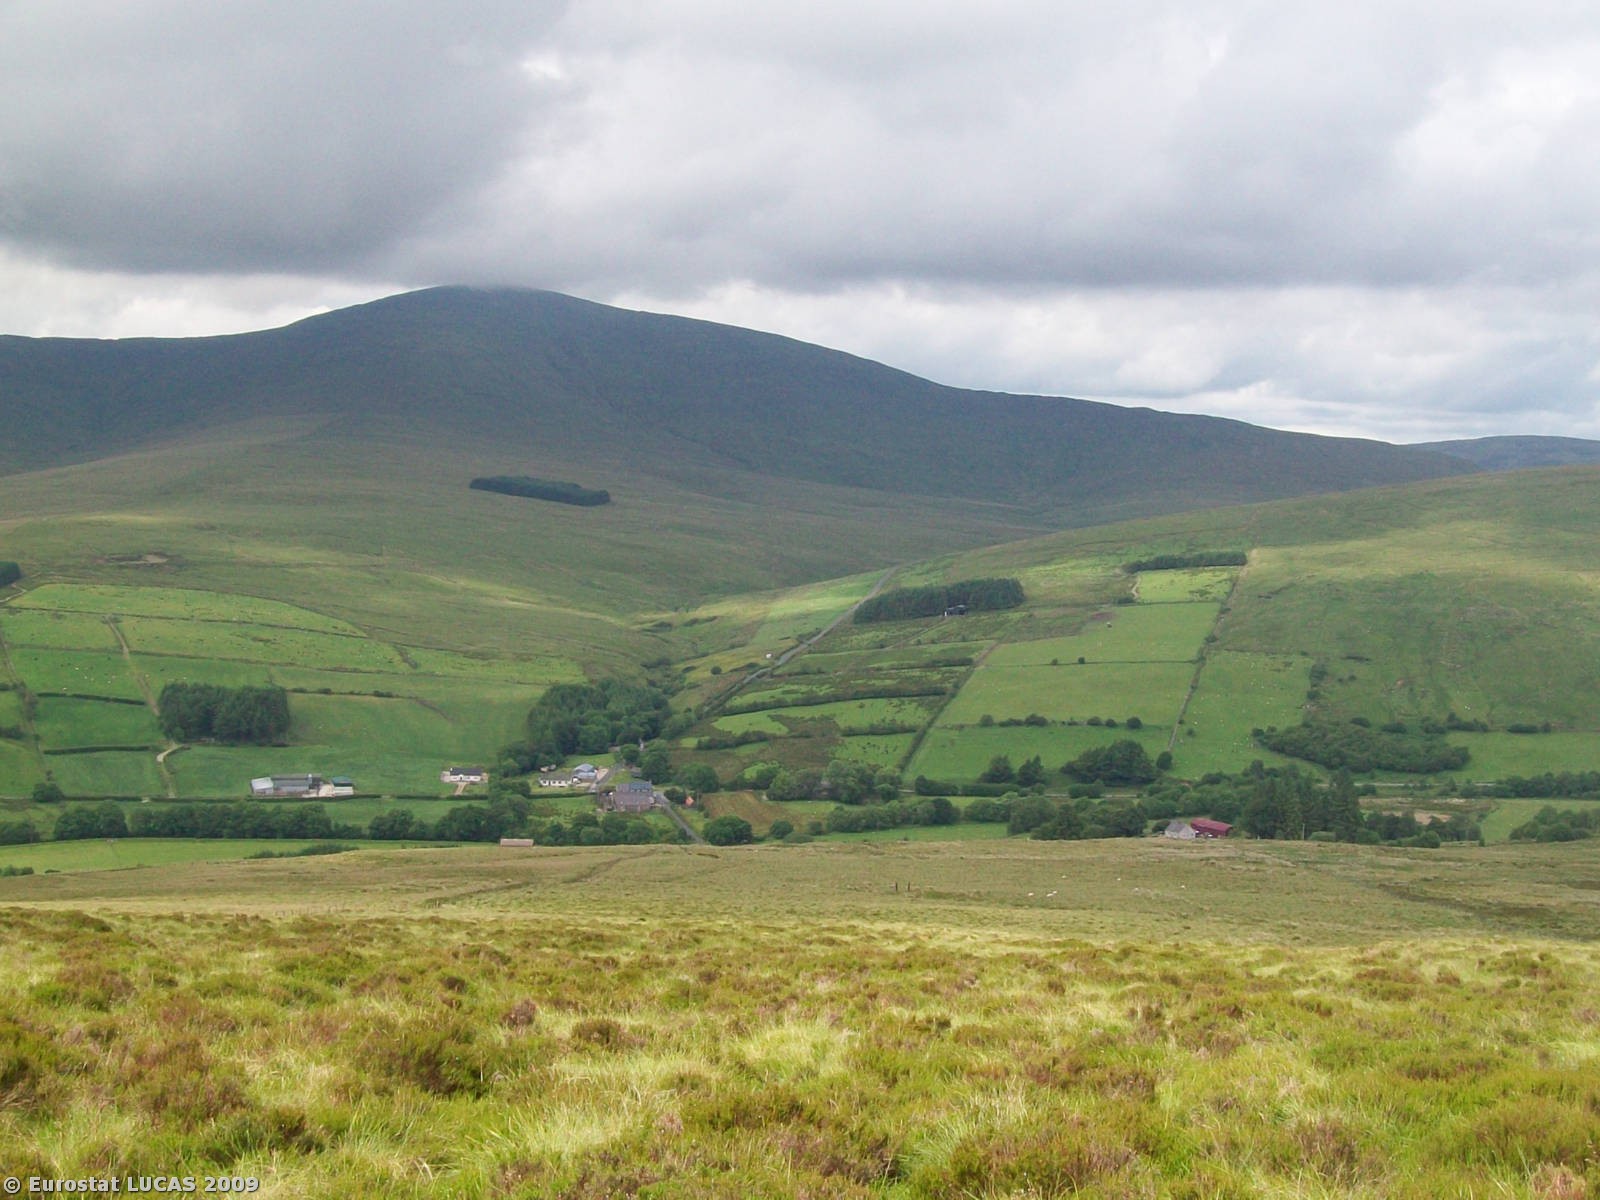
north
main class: Wetlands
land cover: Peatbogs
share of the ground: > 75 %
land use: Unused
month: July
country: GB
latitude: 54.7681
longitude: -6.9713
